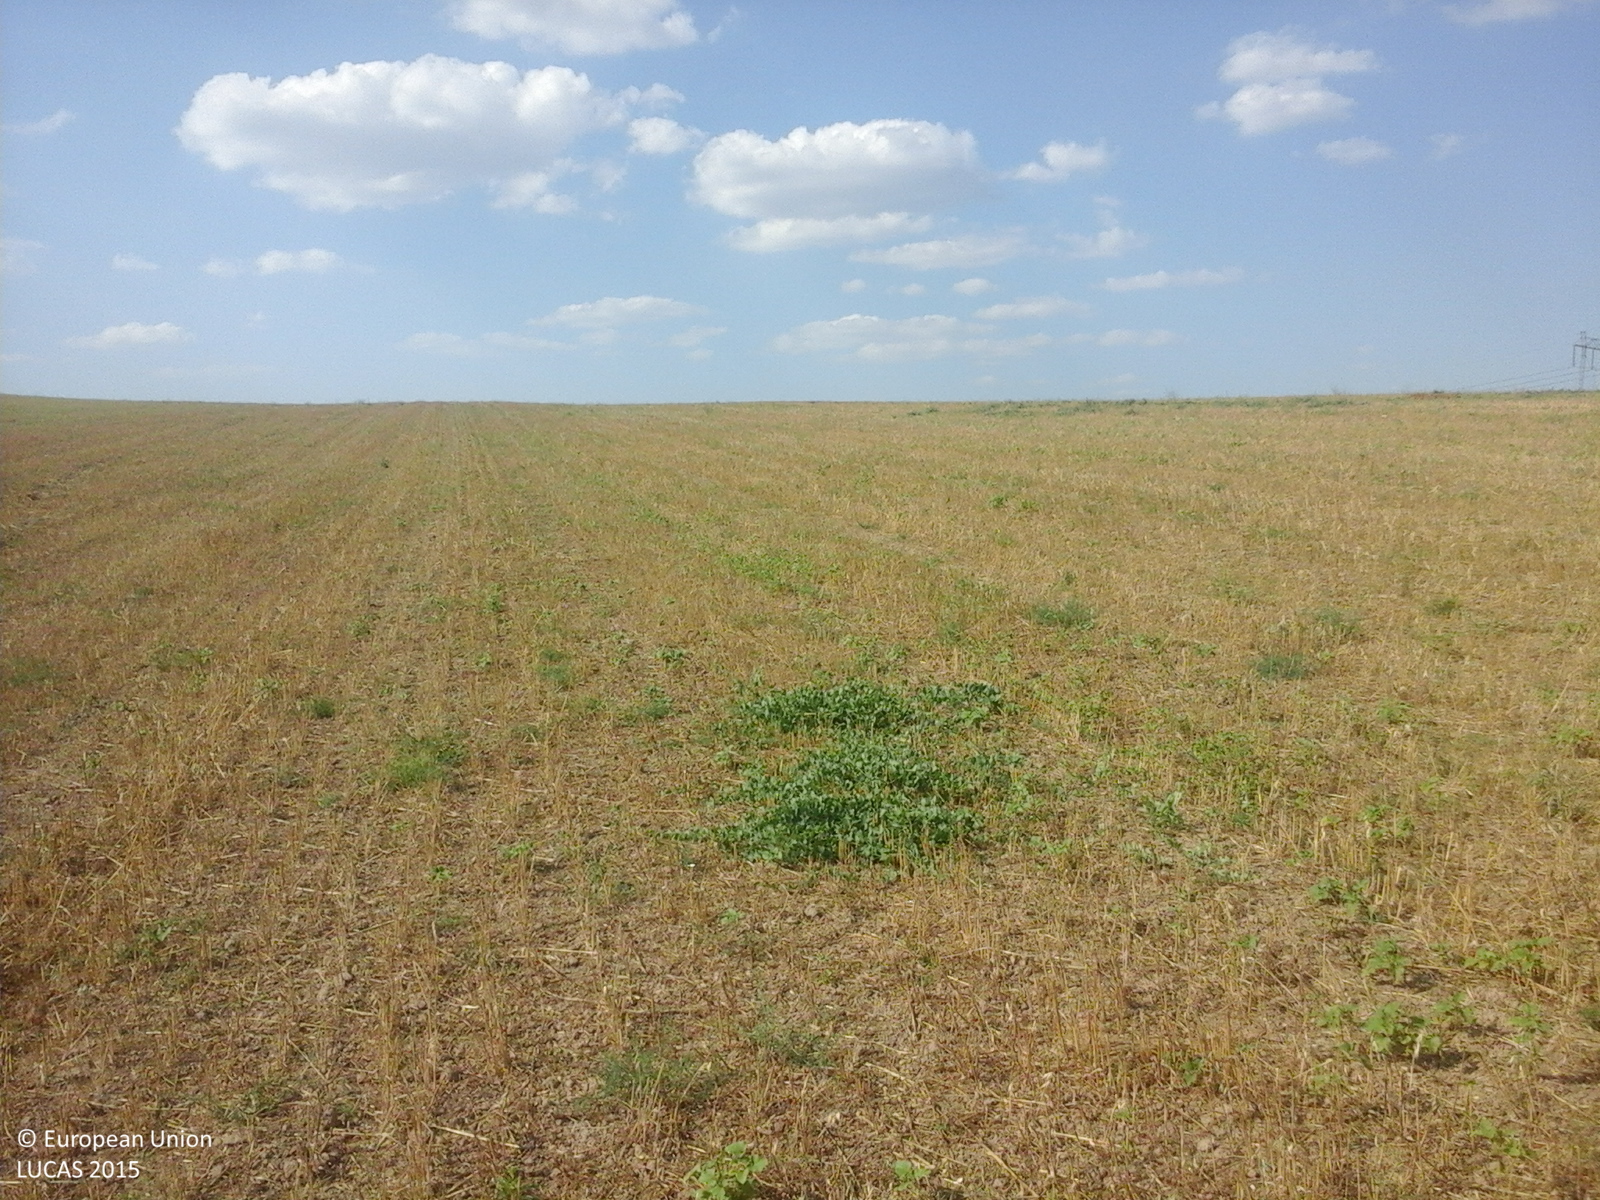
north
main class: Cropland
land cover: Oats
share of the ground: 25 - 50 %
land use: Agriculture (excluding fallow land and kitchen gardens)
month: August
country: RO
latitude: 44.5941
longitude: 28.0616
